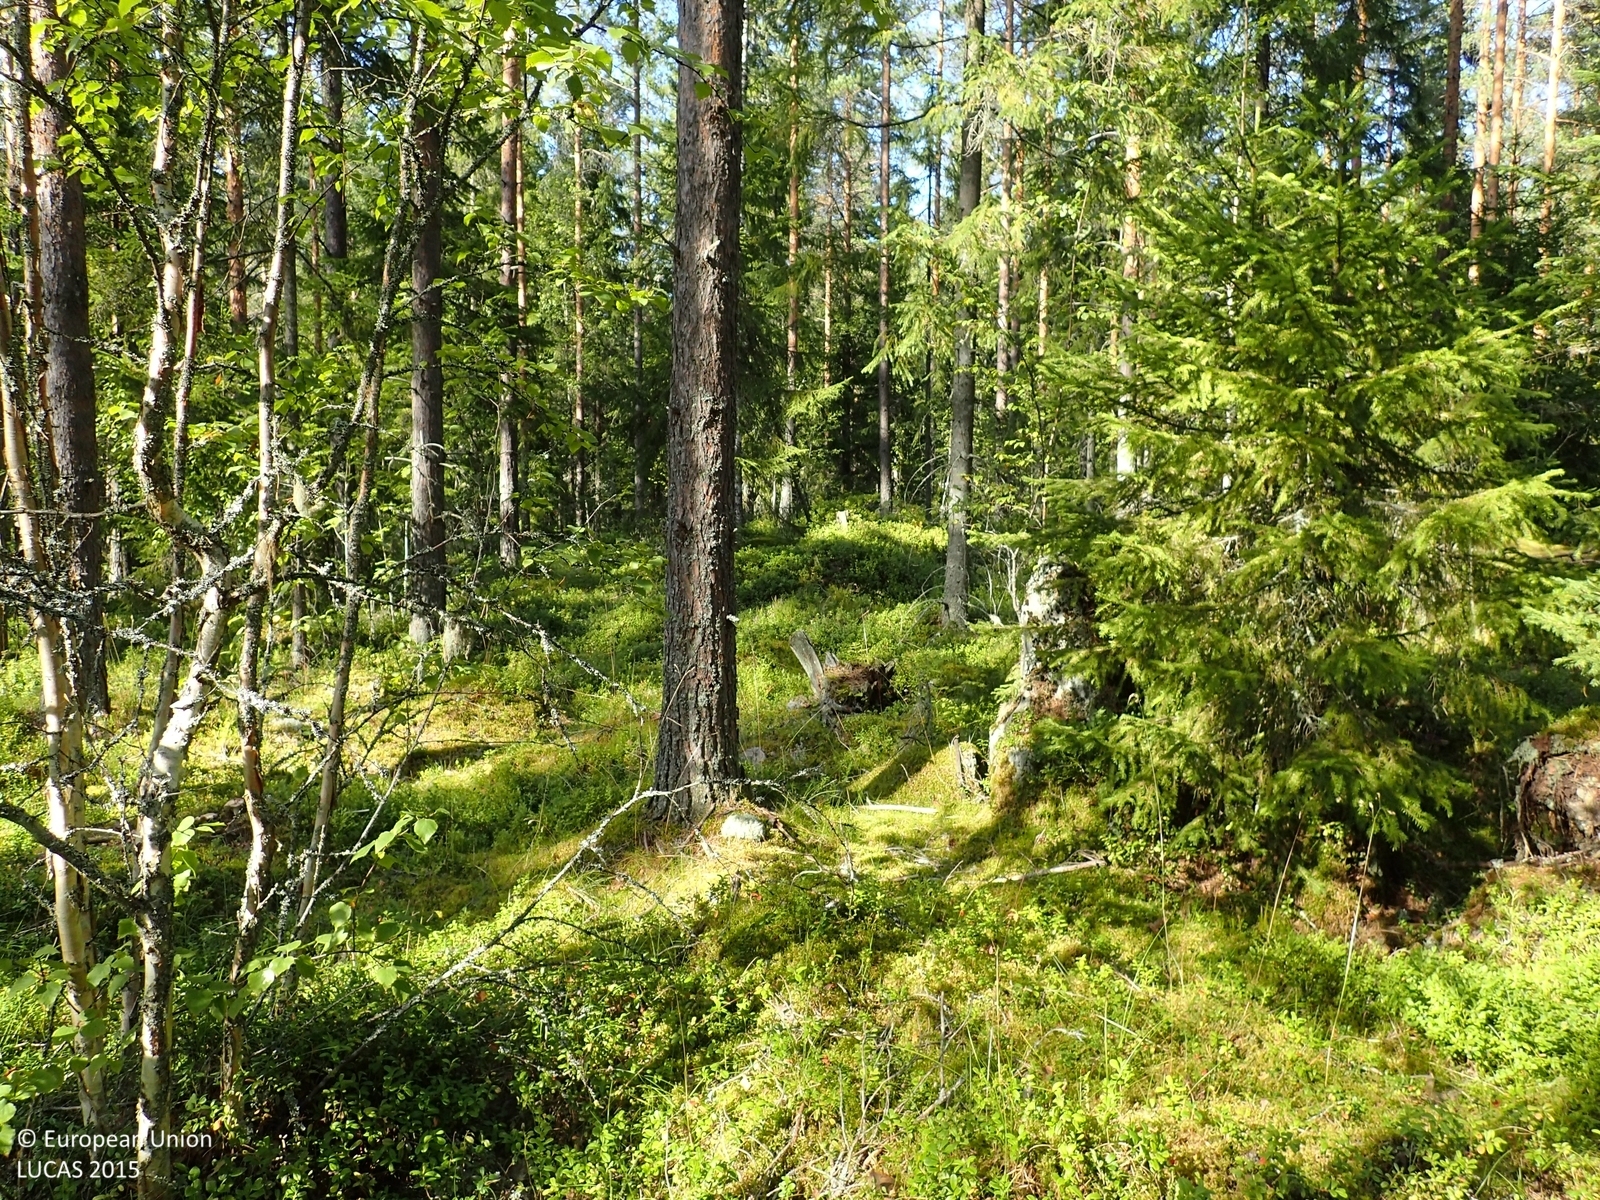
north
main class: Woodland
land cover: Other coniferous woodland
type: boreal forest
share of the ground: > 75 %
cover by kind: coniferous forest trees 65 %, shrubs 20 %, broadleaved forest trees 10 %, lichens and mosses 5 %
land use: Forestry
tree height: > 5 m
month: August
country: FI
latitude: 62.6494
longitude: 22.3636
